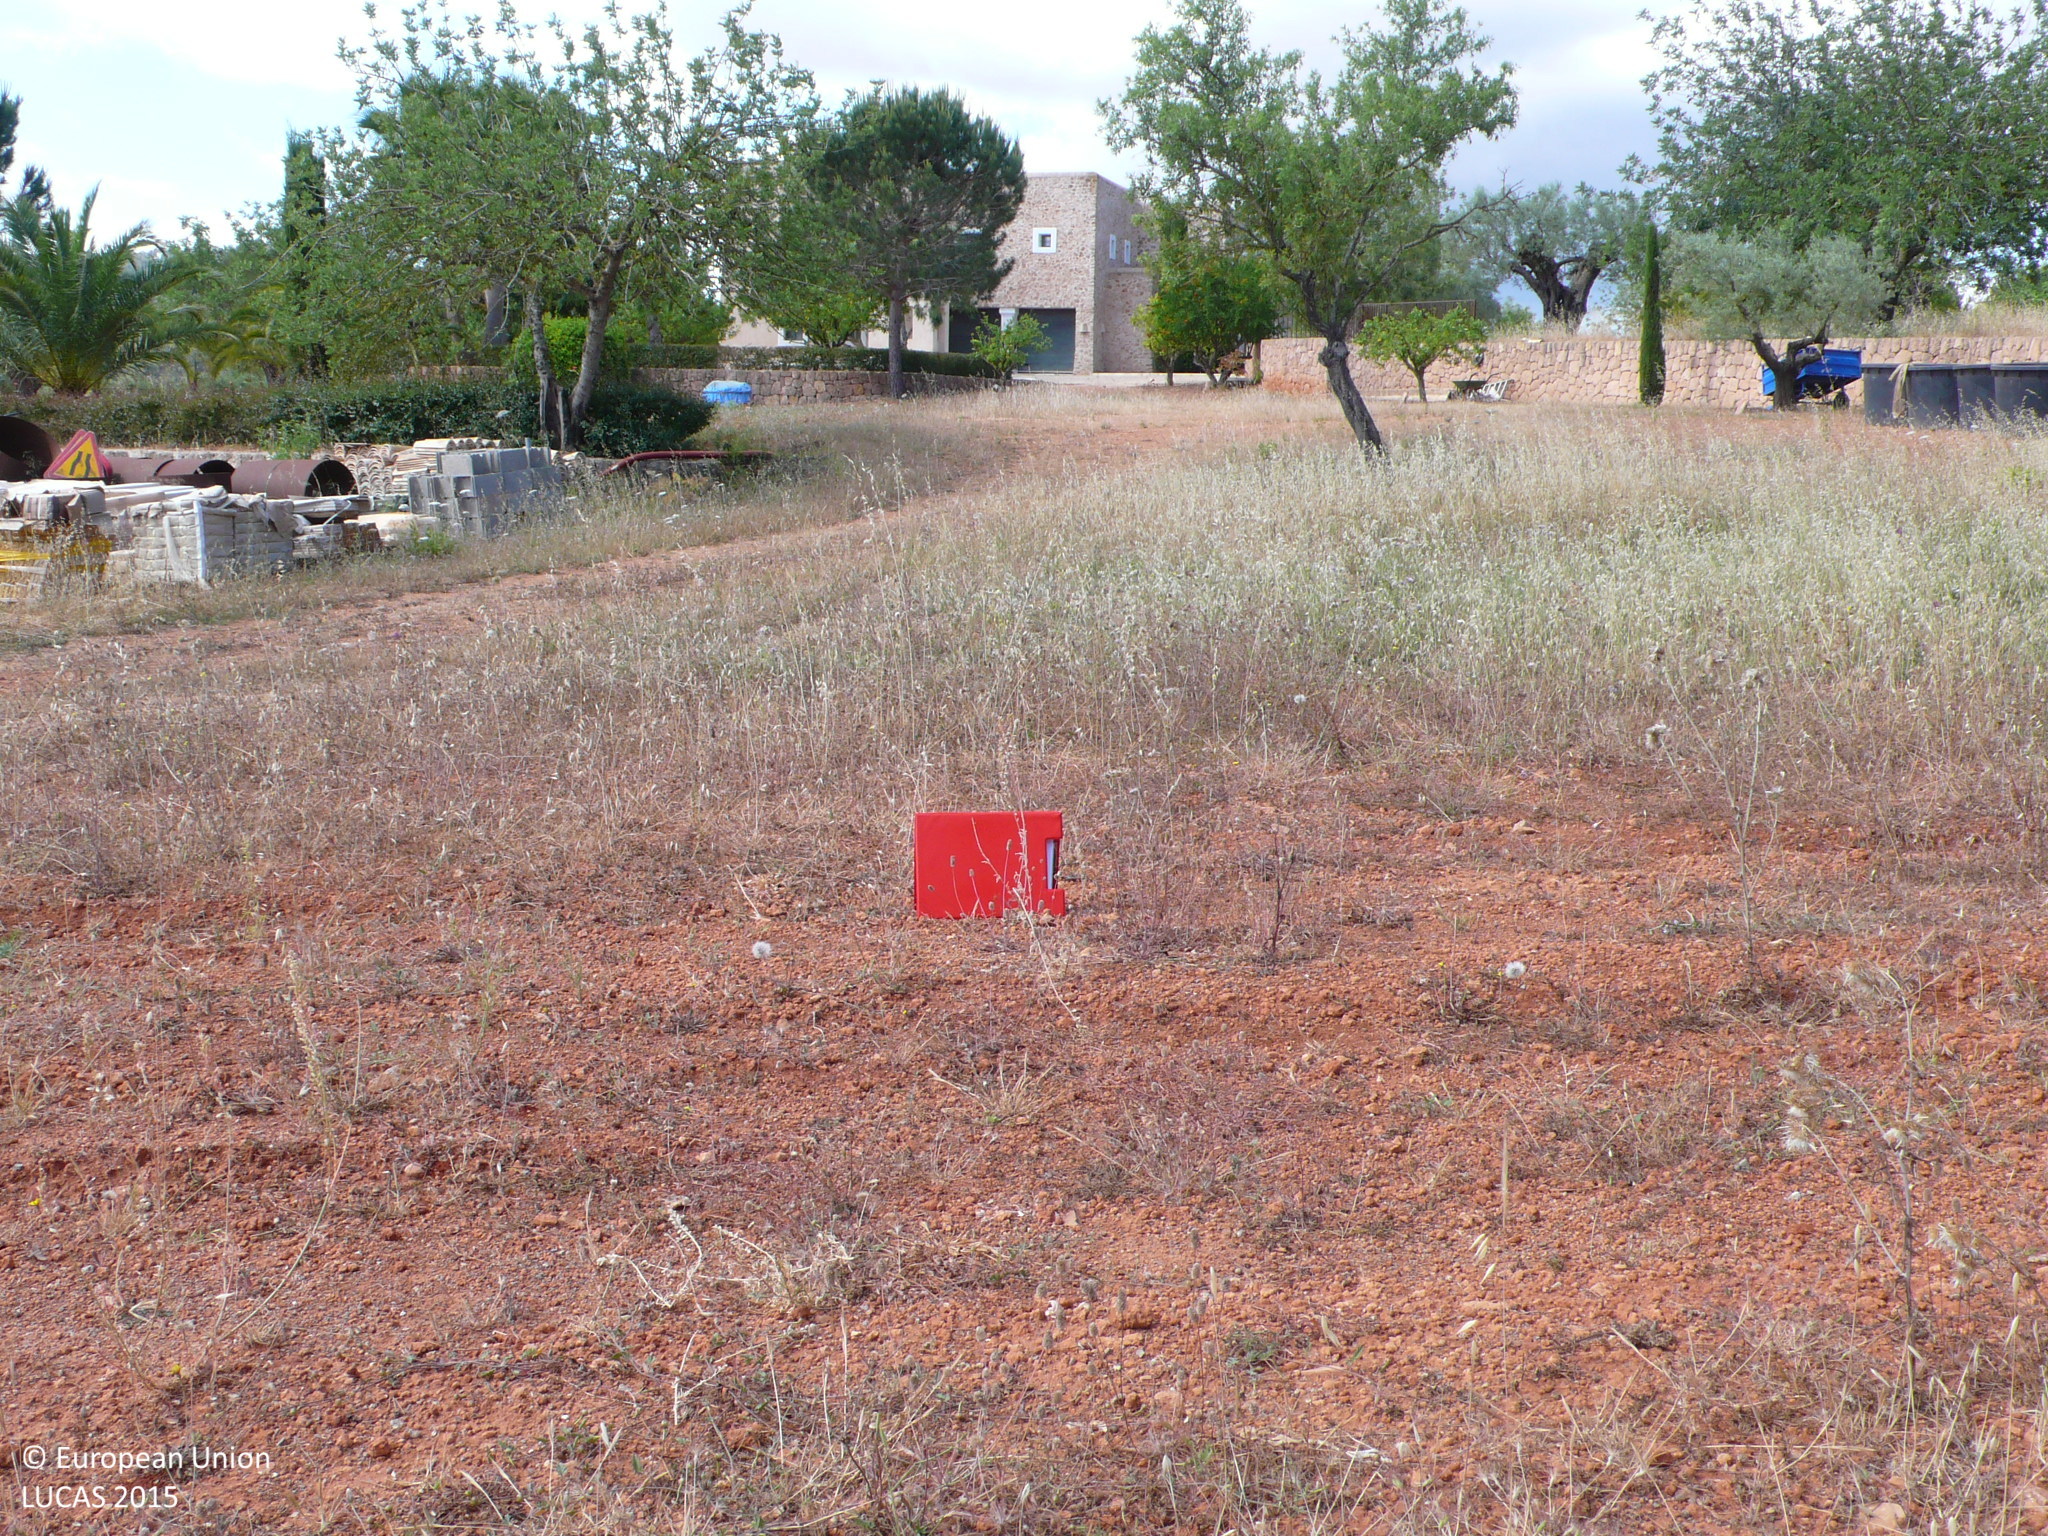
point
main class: Grassland
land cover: Spontaneously vegetated surfaces
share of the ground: 25 - 50 %
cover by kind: consolidated bare surface 60 %, herbaceous plants 40 %
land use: Construction
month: May
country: ES
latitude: 38.9863
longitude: 1.4807
